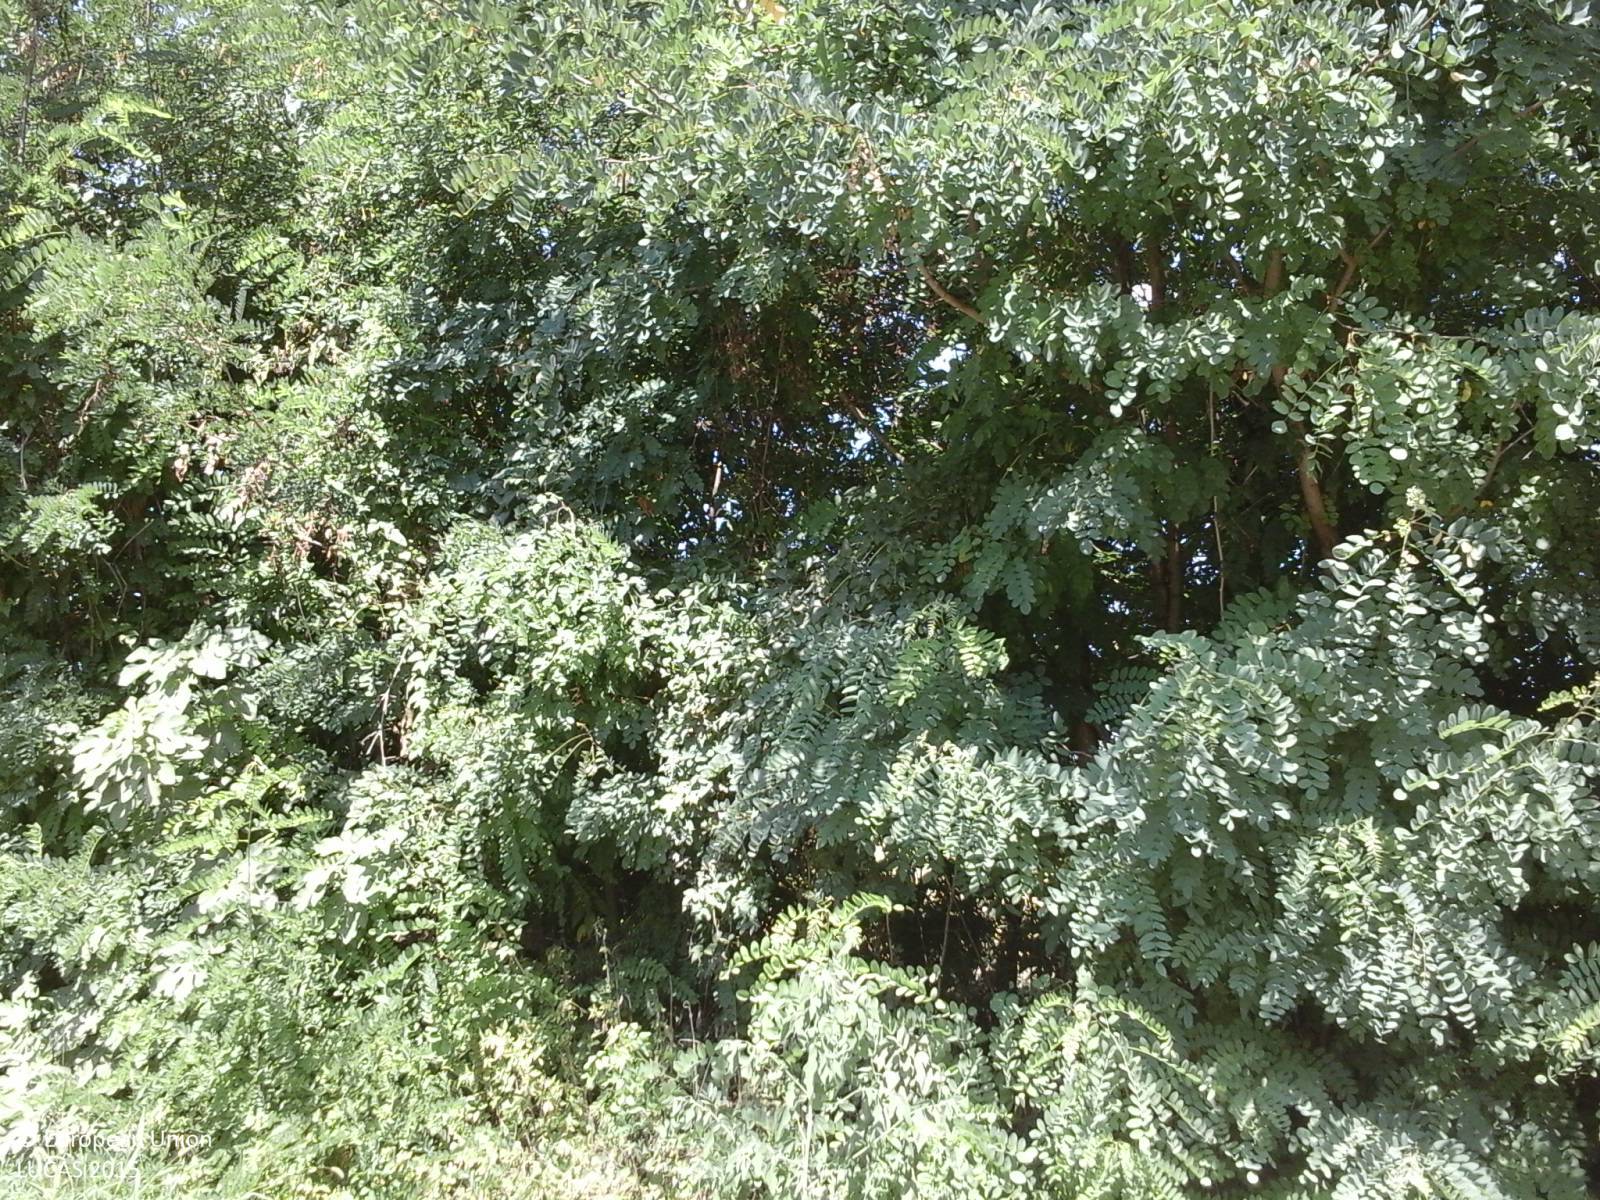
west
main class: Cropland
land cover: Maize
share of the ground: > 75 %
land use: Agriculture (excluding fallow land and kitchen gardens)
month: August
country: IT
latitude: 41.3566
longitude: 14.1559
